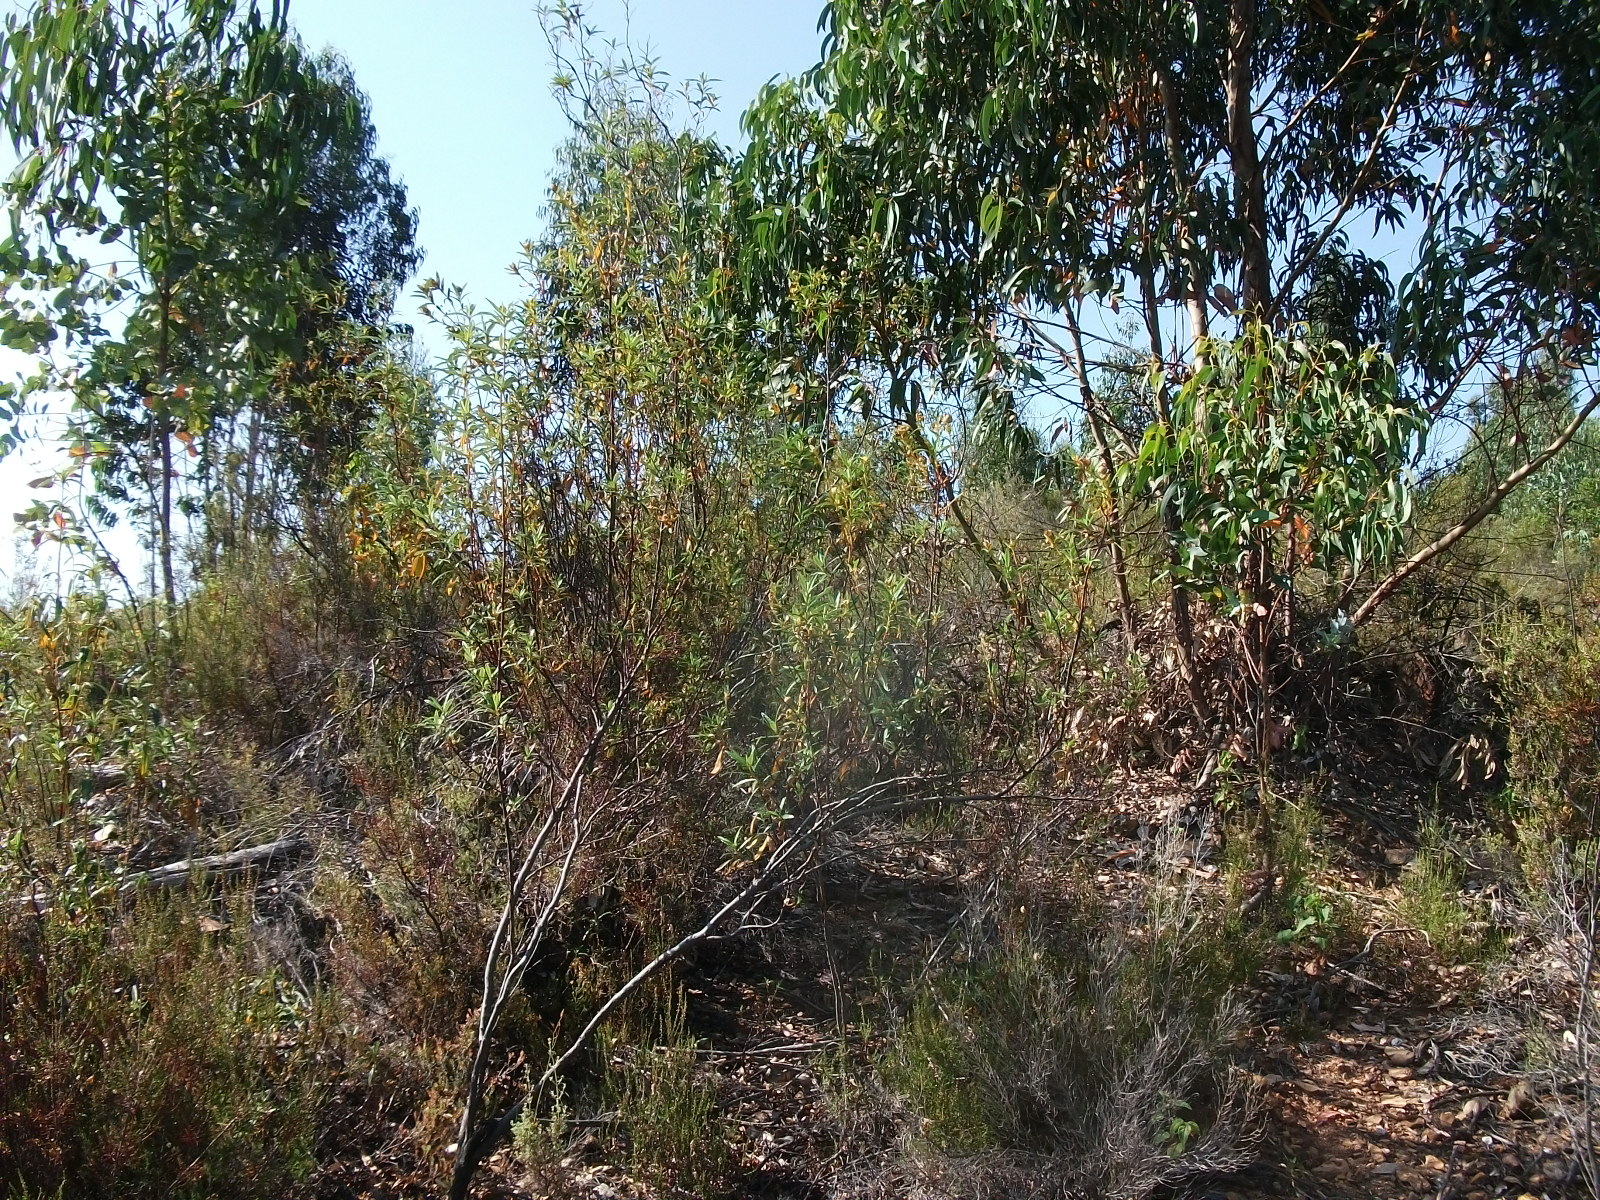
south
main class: Woodland
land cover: Broadleaved woodland
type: exotic forest
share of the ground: 50 - 75 %
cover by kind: broadleaved forest trees 60 %, shrubs 30 %, unconsolidated bare surface 10 %
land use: Forestry
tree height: > 5 m
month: May
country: ES
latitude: 37.5968
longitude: -6.6549
